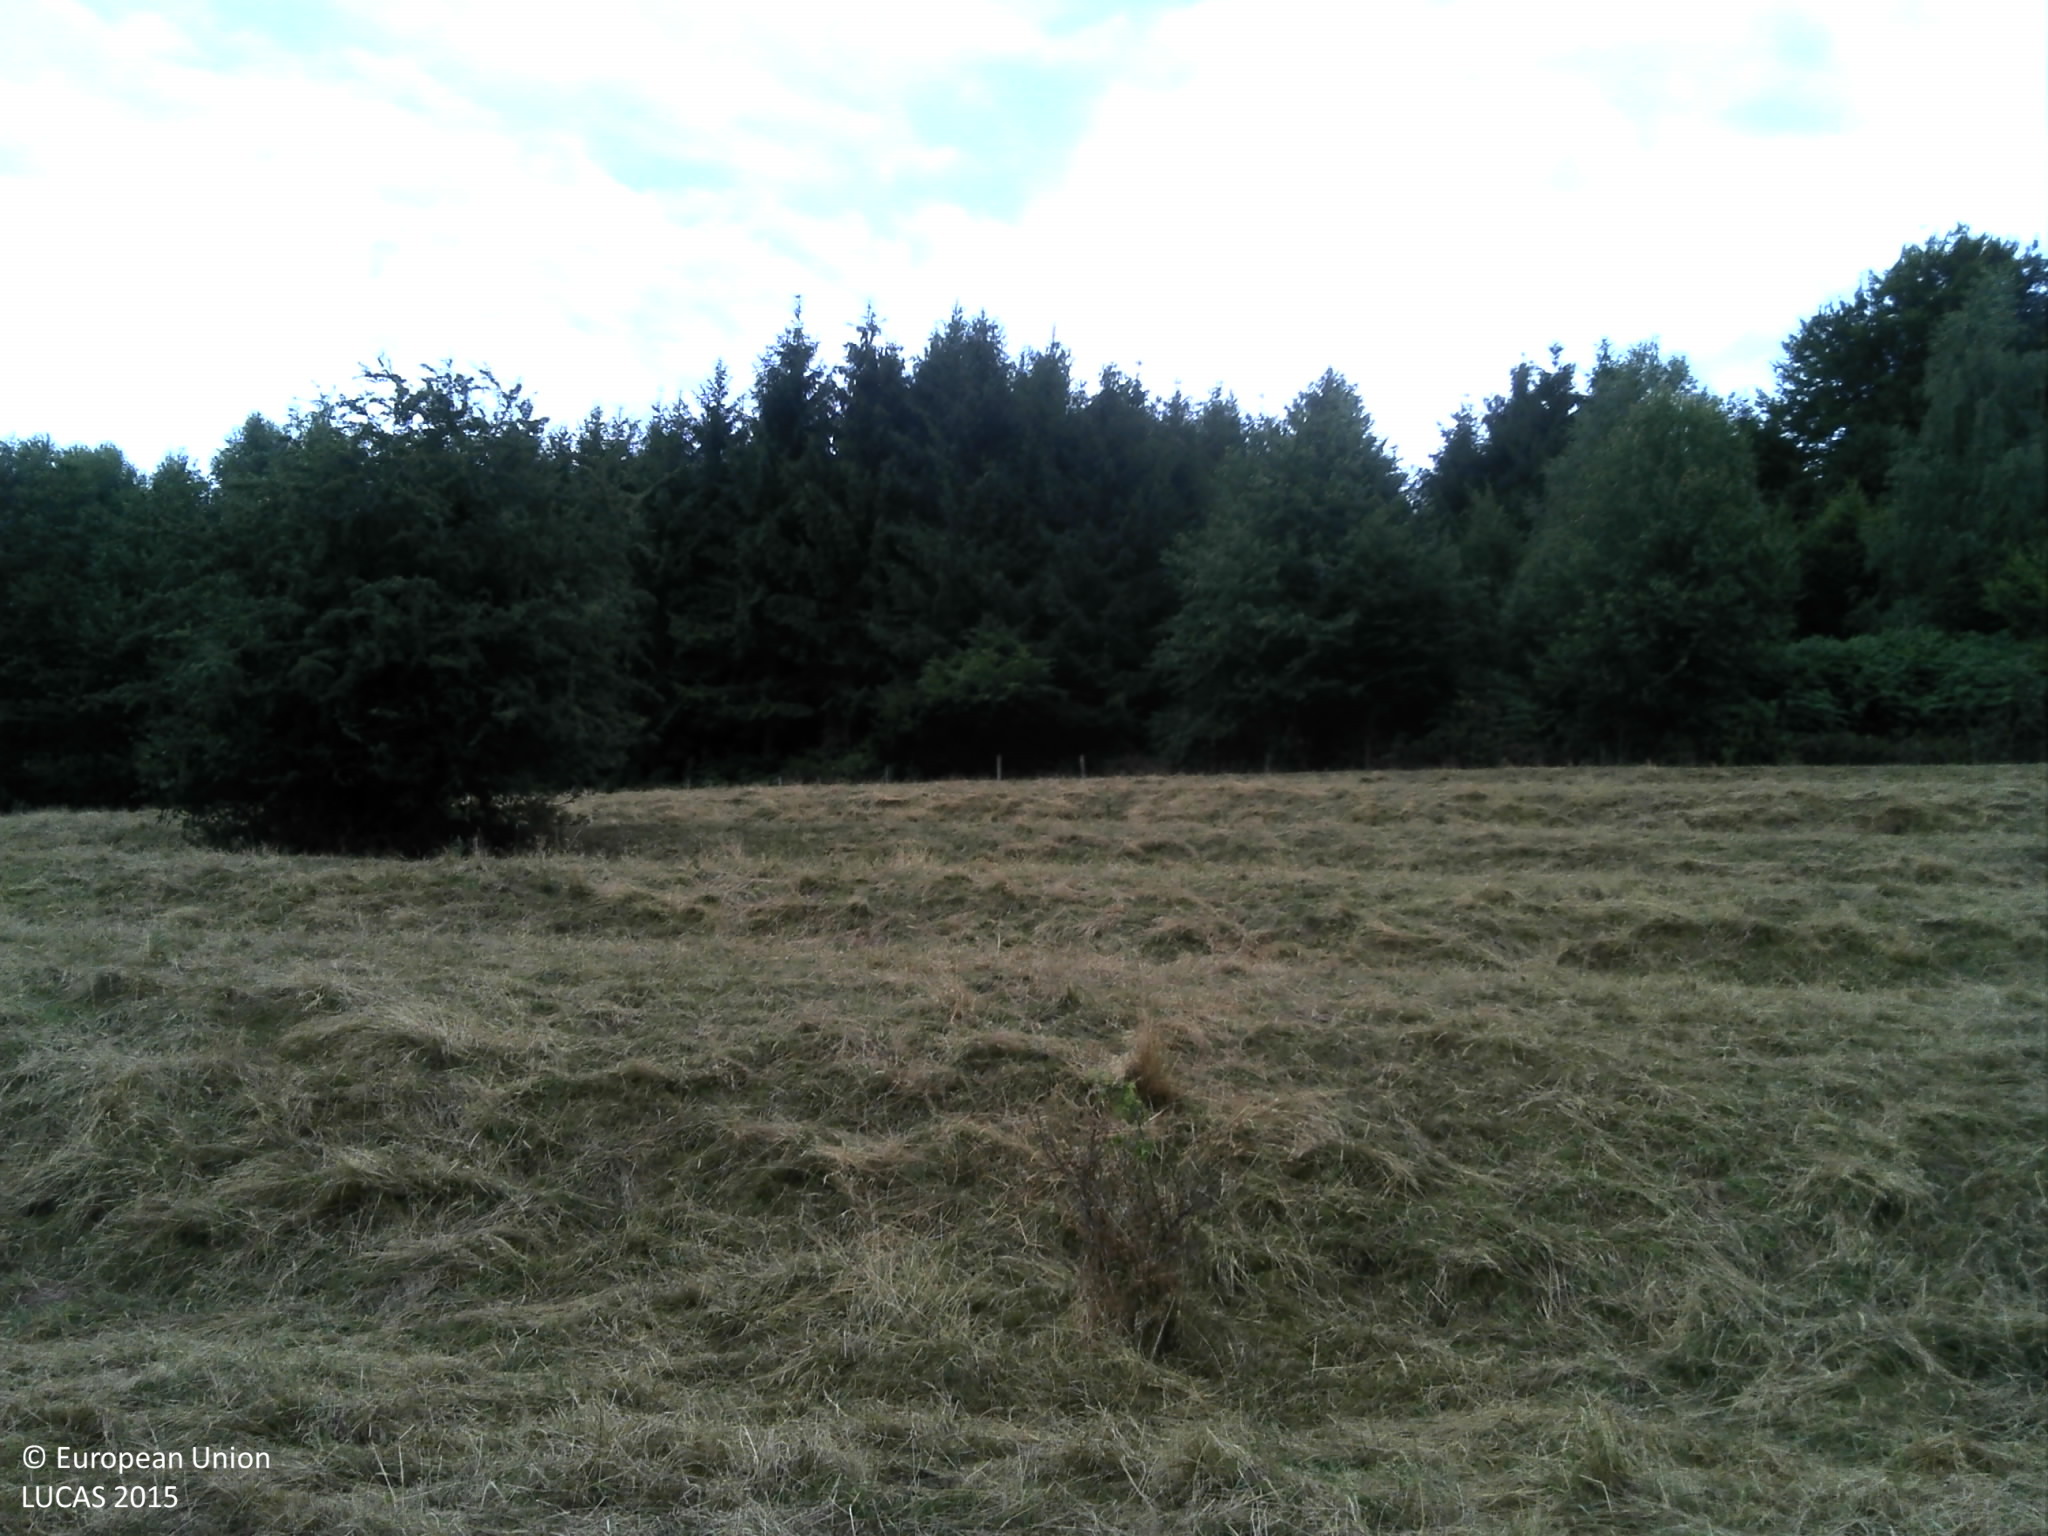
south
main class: Grassland
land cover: Grassland without tree/shrub cover
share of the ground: > 75 %
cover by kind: herbaceous plants 100 %
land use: Agriculture (excluding fallow land and kitchen gardens)
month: July
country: FR
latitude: 48.7478
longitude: 7.2670
